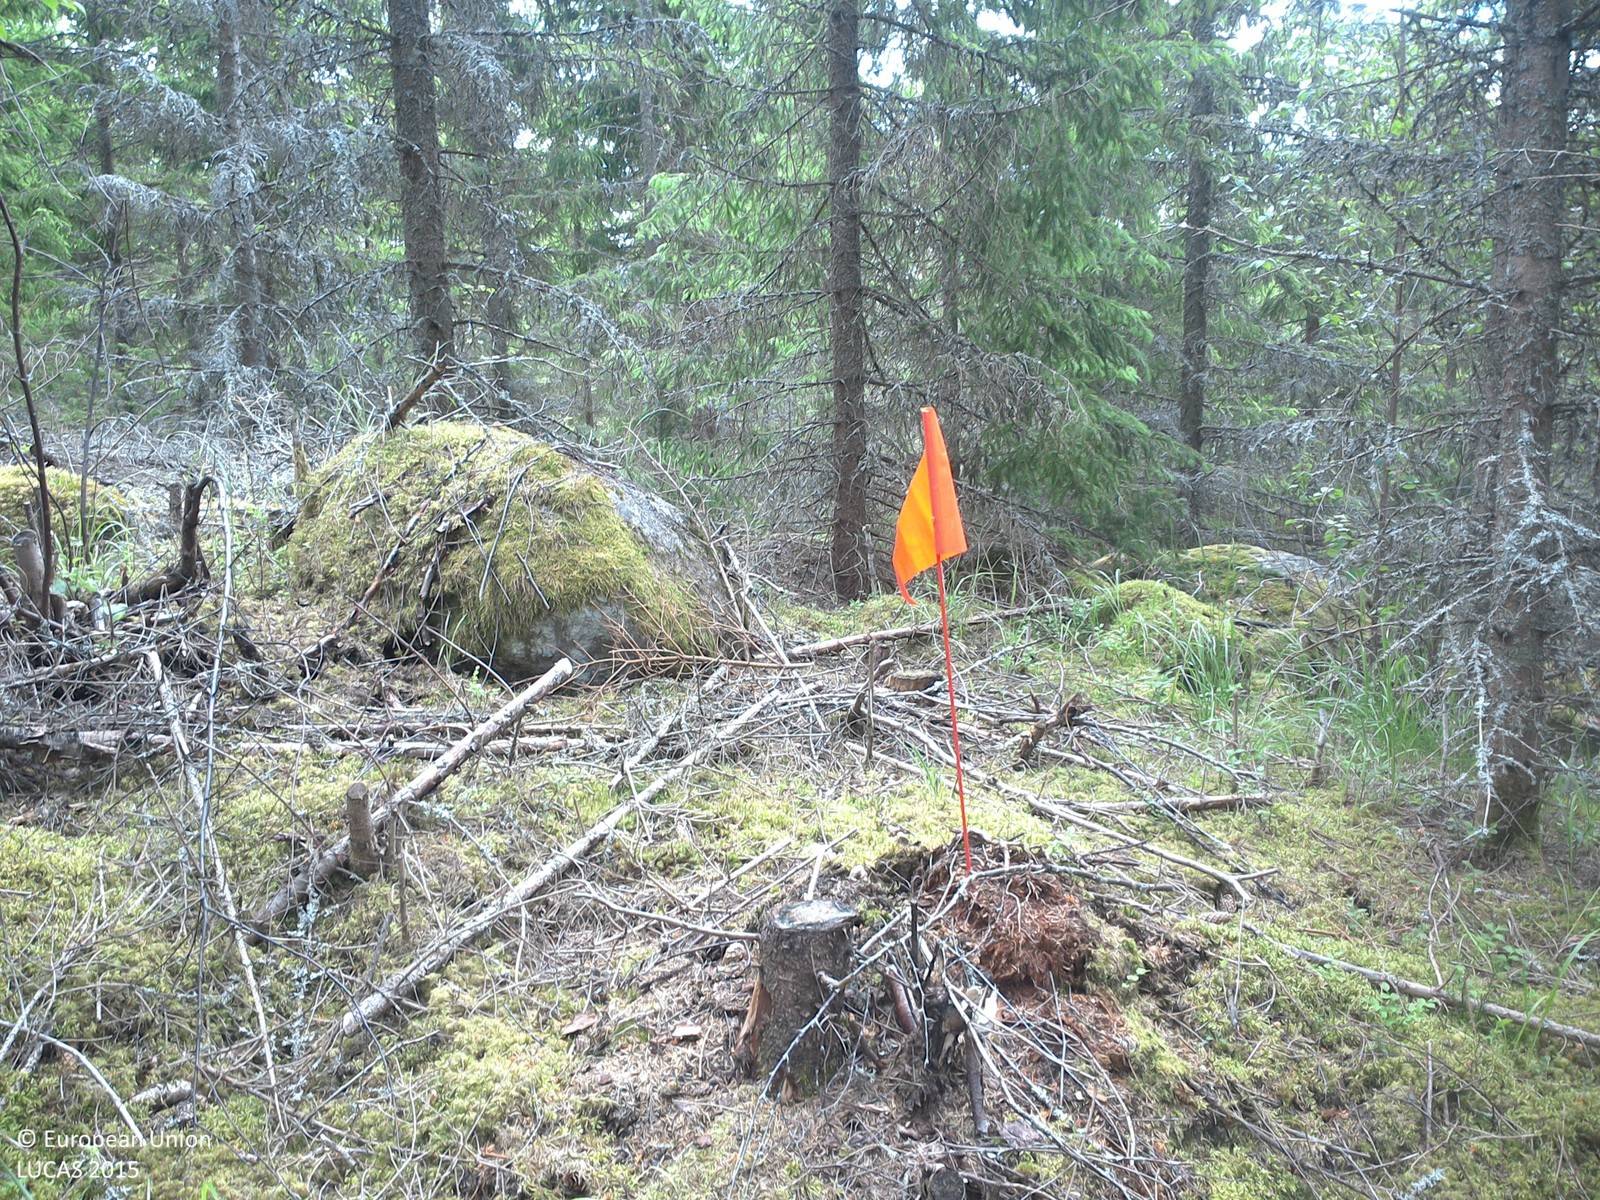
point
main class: Woodland
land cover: Spruce dominated coniferous woodland
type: boreal forest
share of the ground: 50 - 75 %
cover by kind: coniferous forest trees 60 %, lichens and mosses 40 %
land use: Forestry
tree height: > 5 m
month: June
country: SE
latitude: 58.0132
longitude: 16.0050
